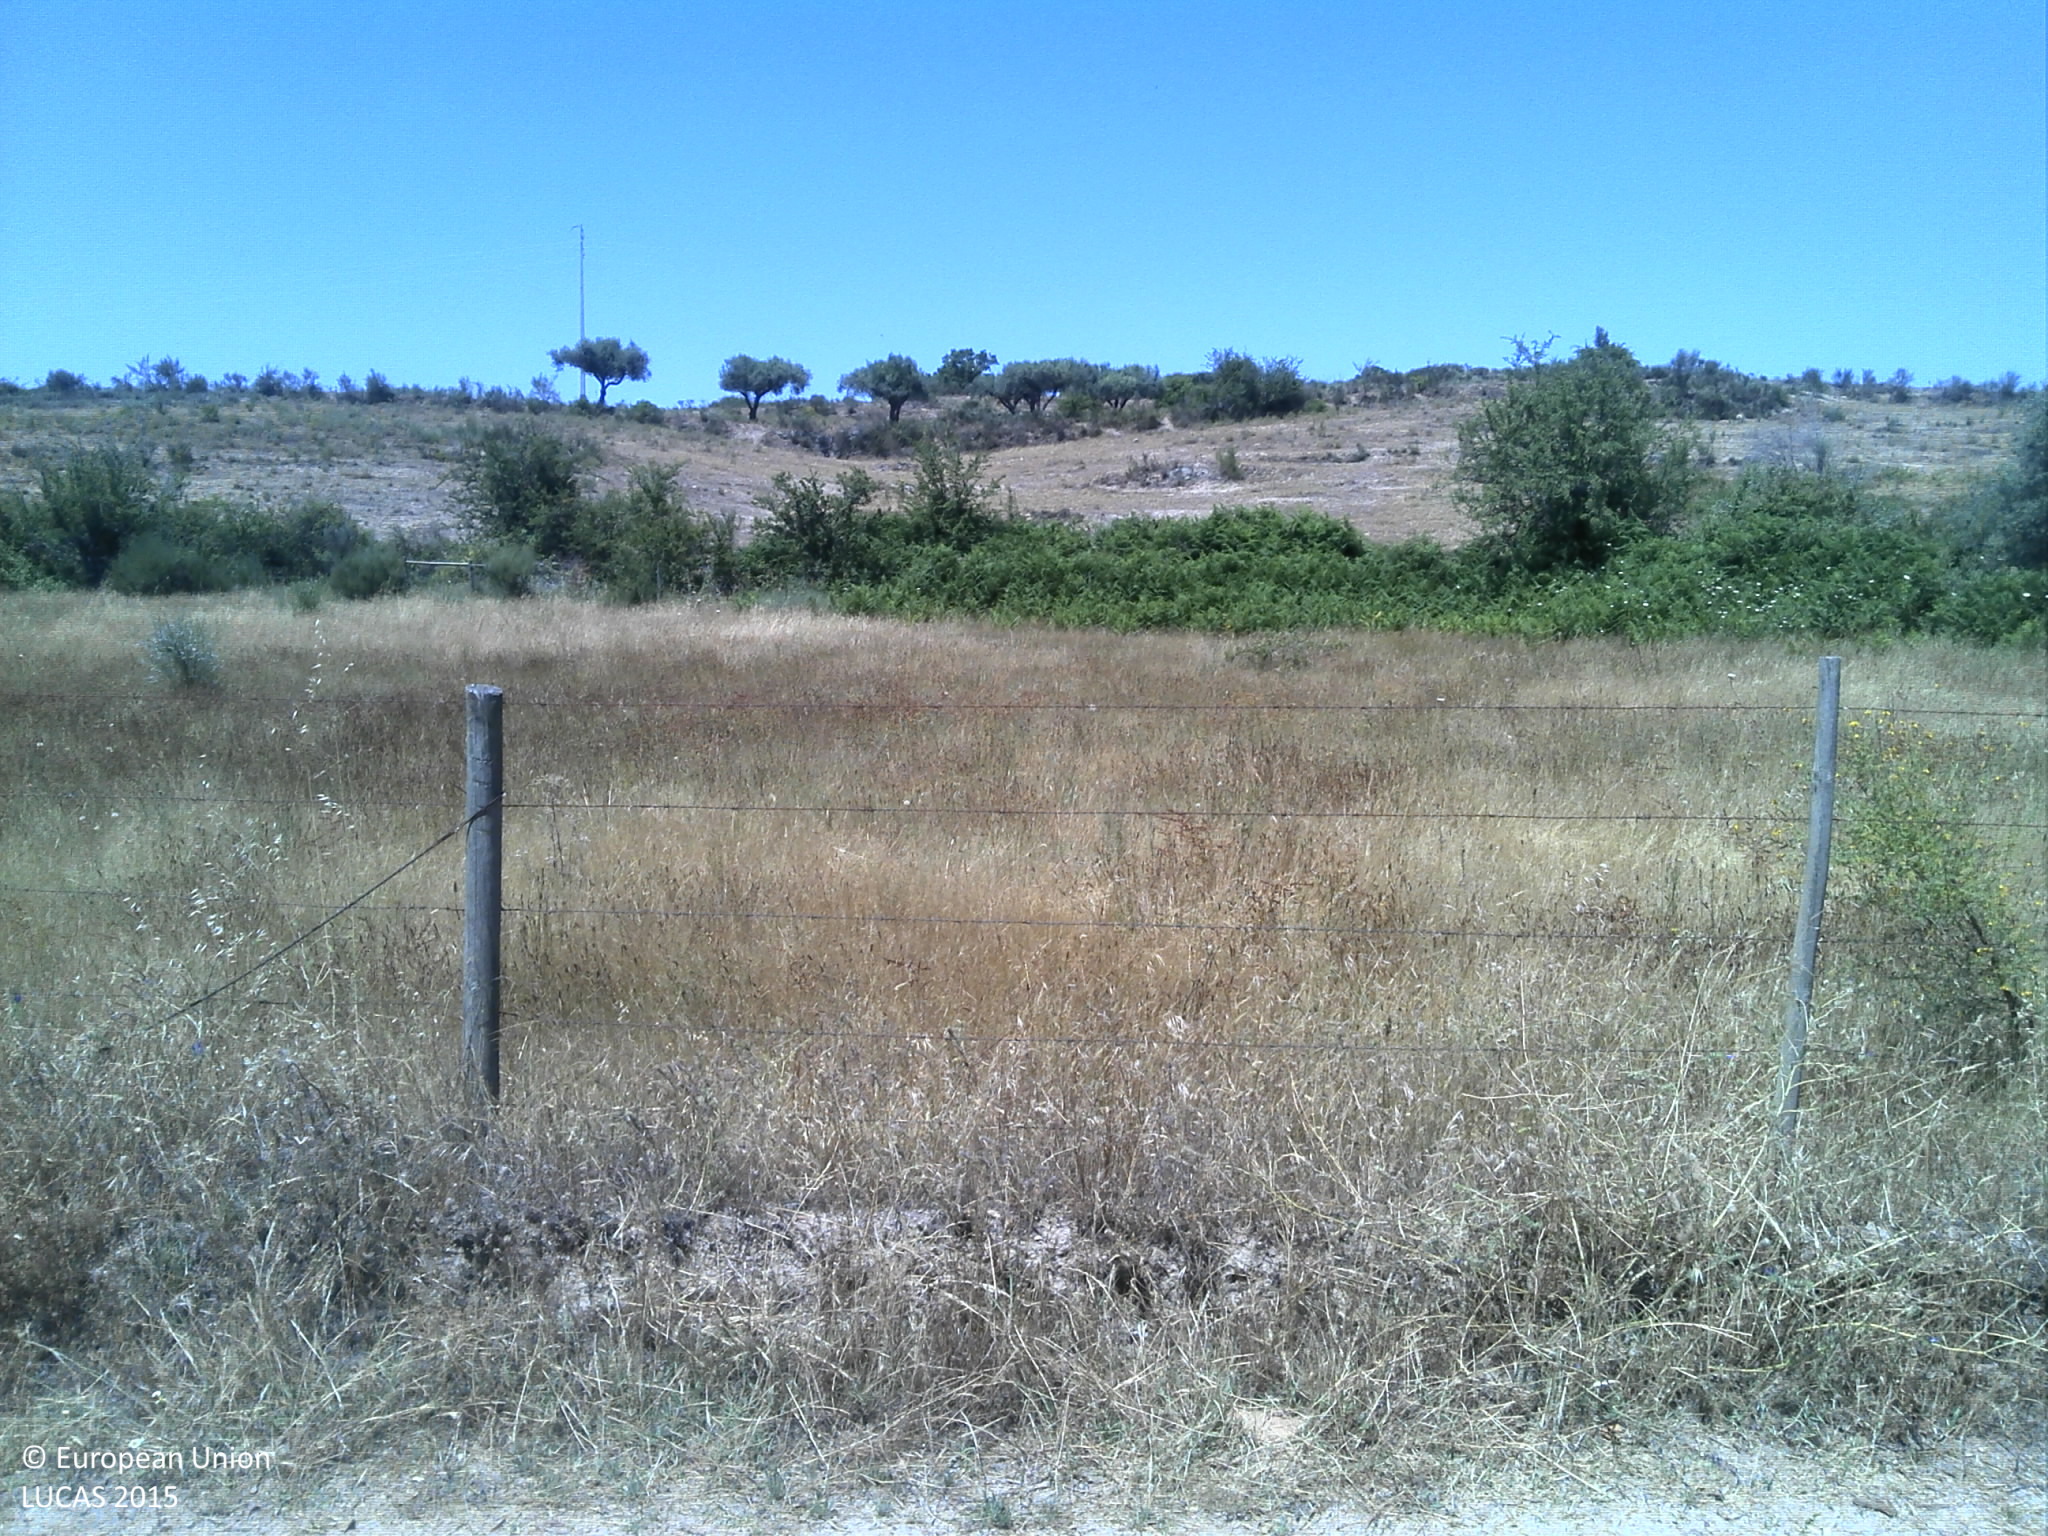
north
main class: Grassland
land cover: Grassland without tree/shrub cover
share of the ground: 50 - 75 %
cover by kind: herbaceous plants 65 %, unconsolidated bare surface 30 %
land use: Agriculture (excluding fallow land and kitchen gardens)
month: June
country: PT
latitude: 40.1119
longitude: -7.2391
